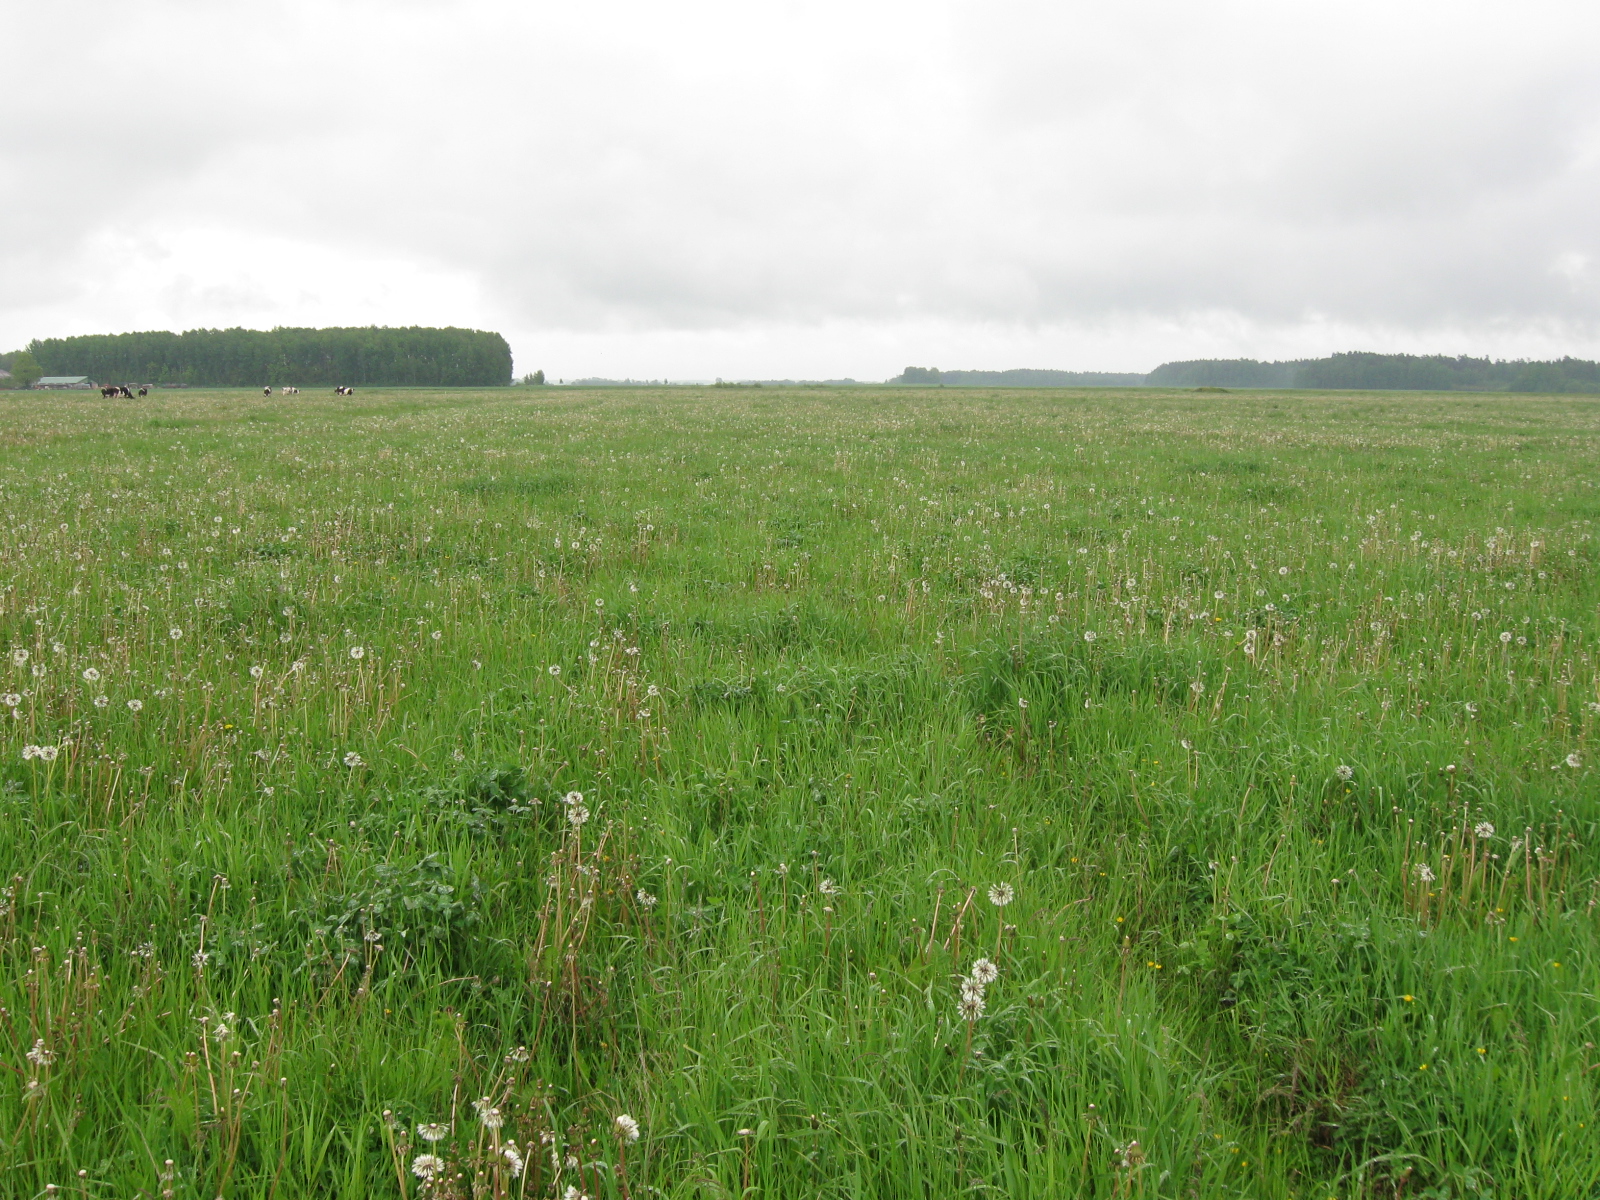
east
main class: Grassland
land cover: Grassland without tree/shrub cover
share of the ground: > 75 %
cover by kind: herbaceous plants 100 %
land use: Agriculture (excluding fallow land and kitchen gardens)
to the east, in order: Grassland without tree/shrub cover
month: May
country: LT
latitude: 55.0166
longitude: 22.7822
